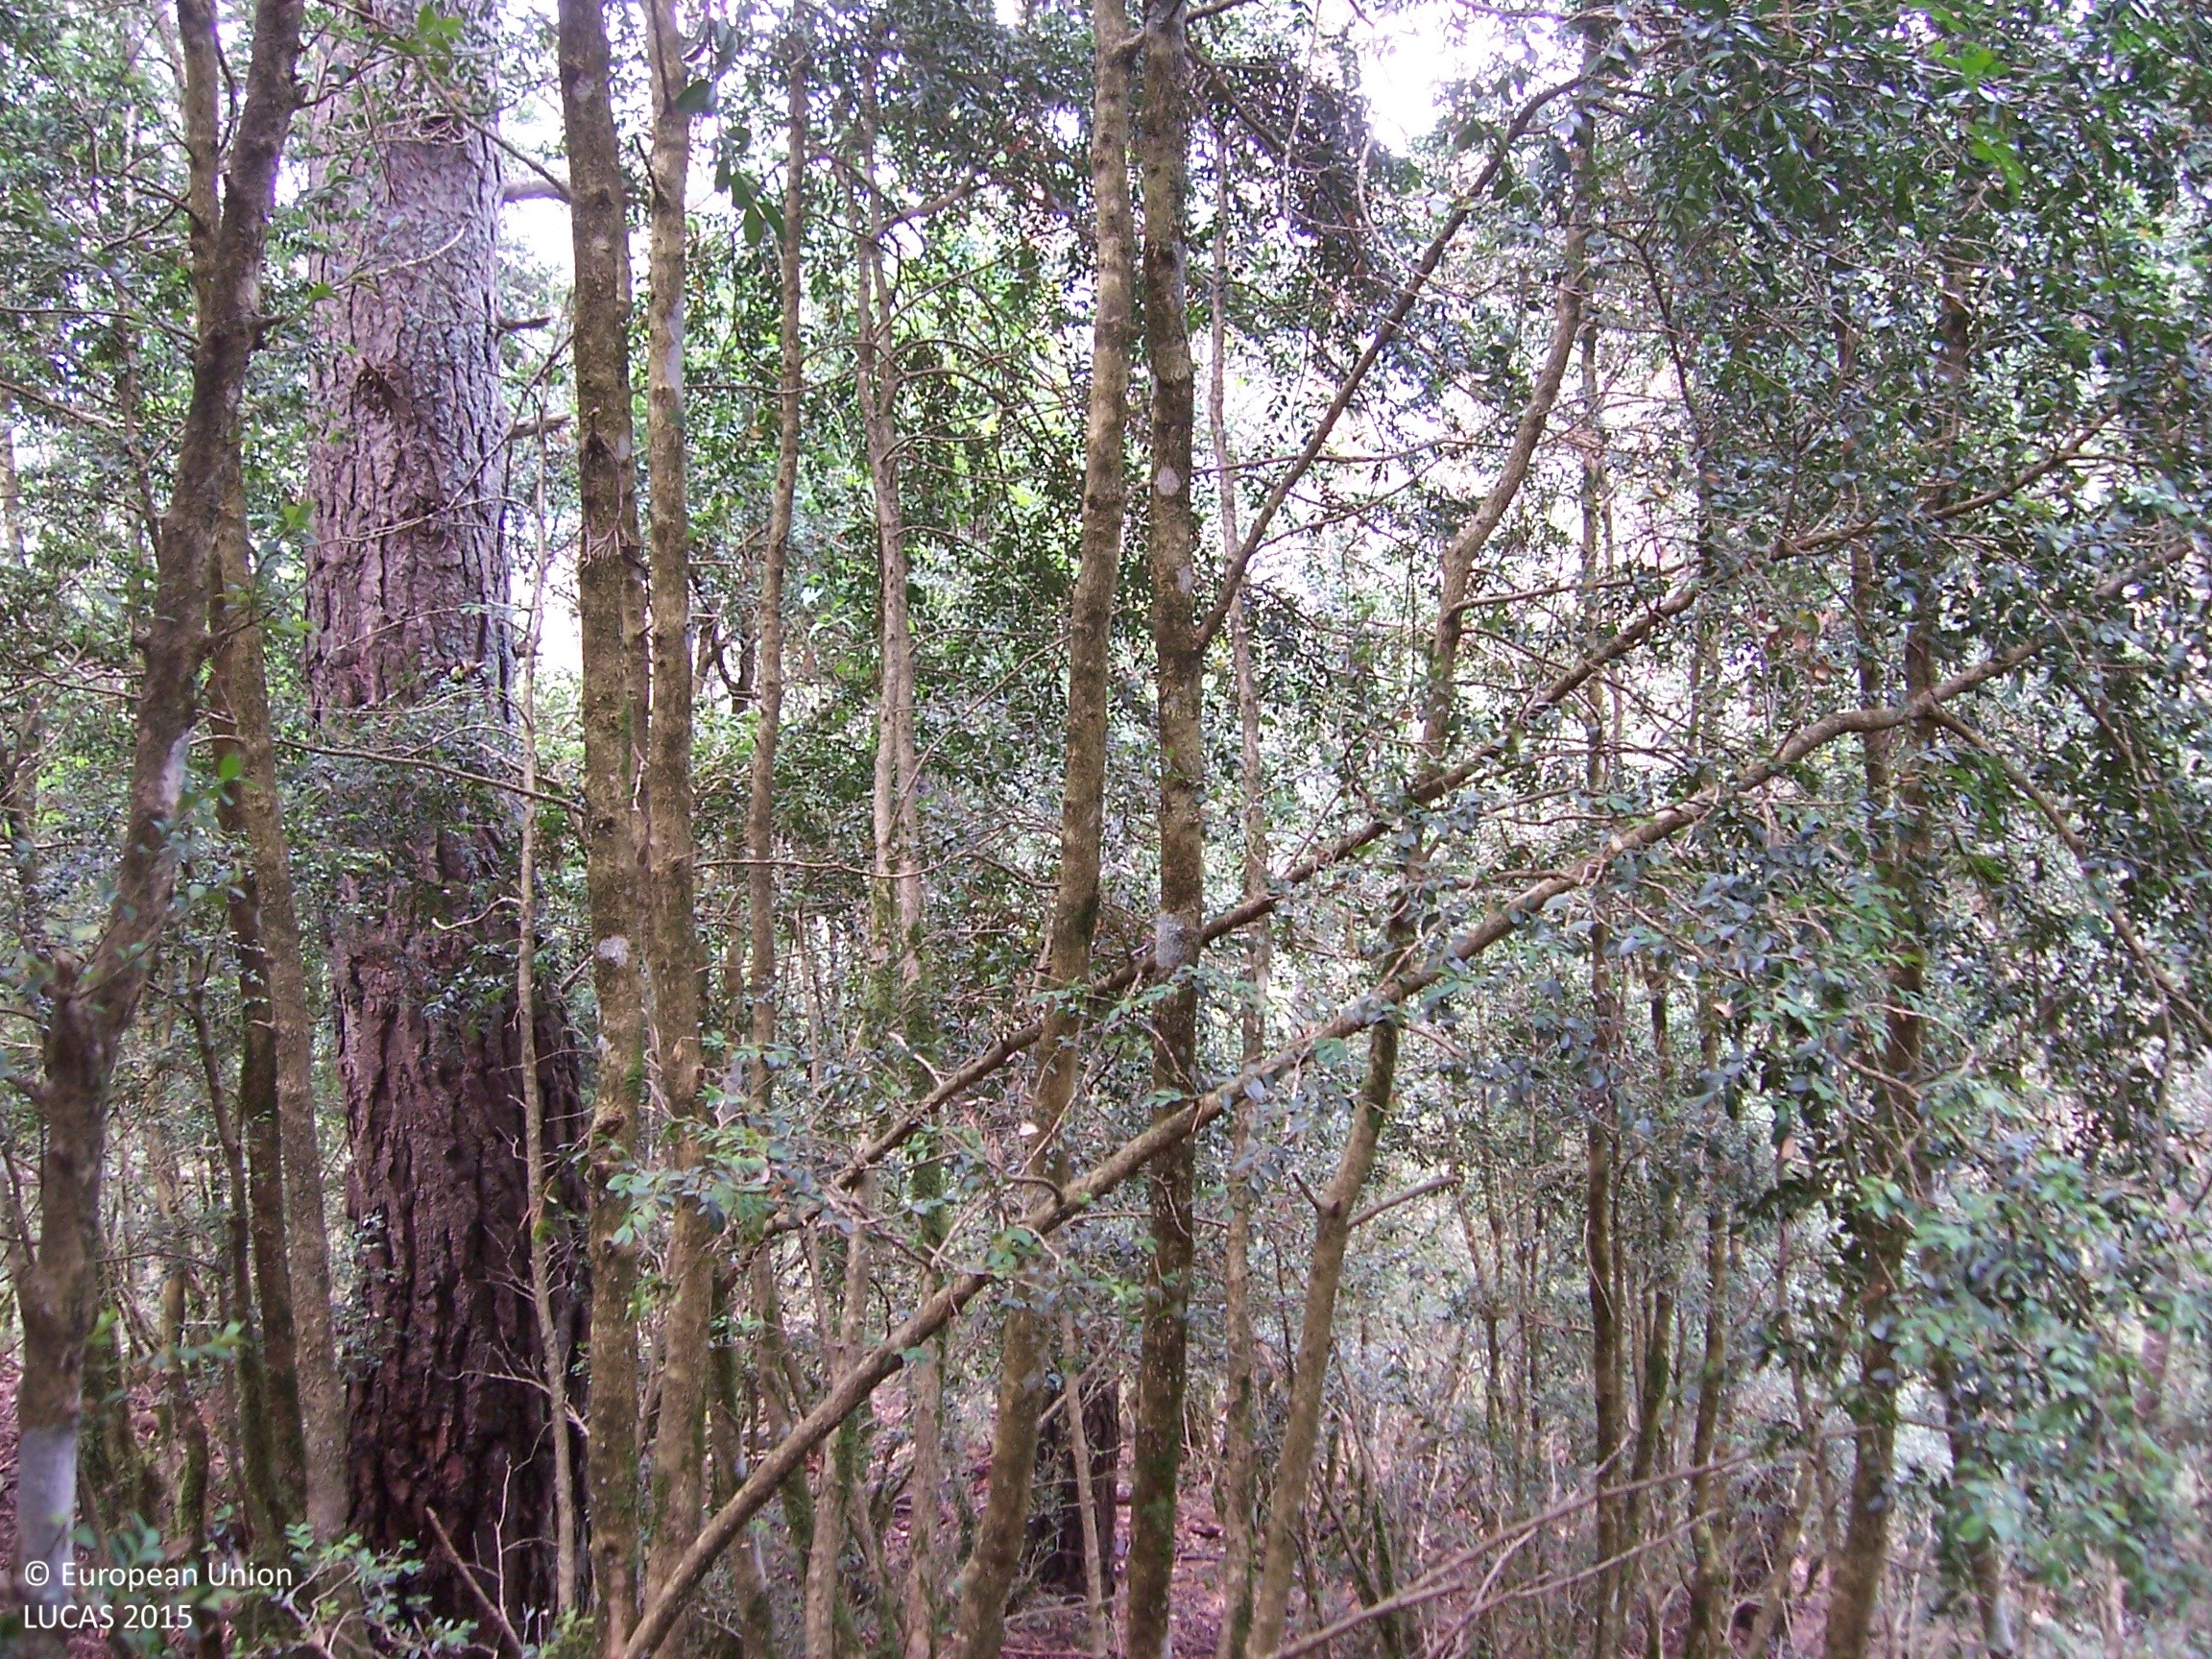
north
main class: Woodland
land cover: Pine dominated coniferous woodland
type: alpine coniferous forest
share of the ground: > 75 %
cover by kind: coniferous forest trees 100 %
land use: Forestry
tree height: > 5 m
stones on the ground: < 10 %
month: August
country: ES
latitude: 42.6134
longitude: -0.3514
